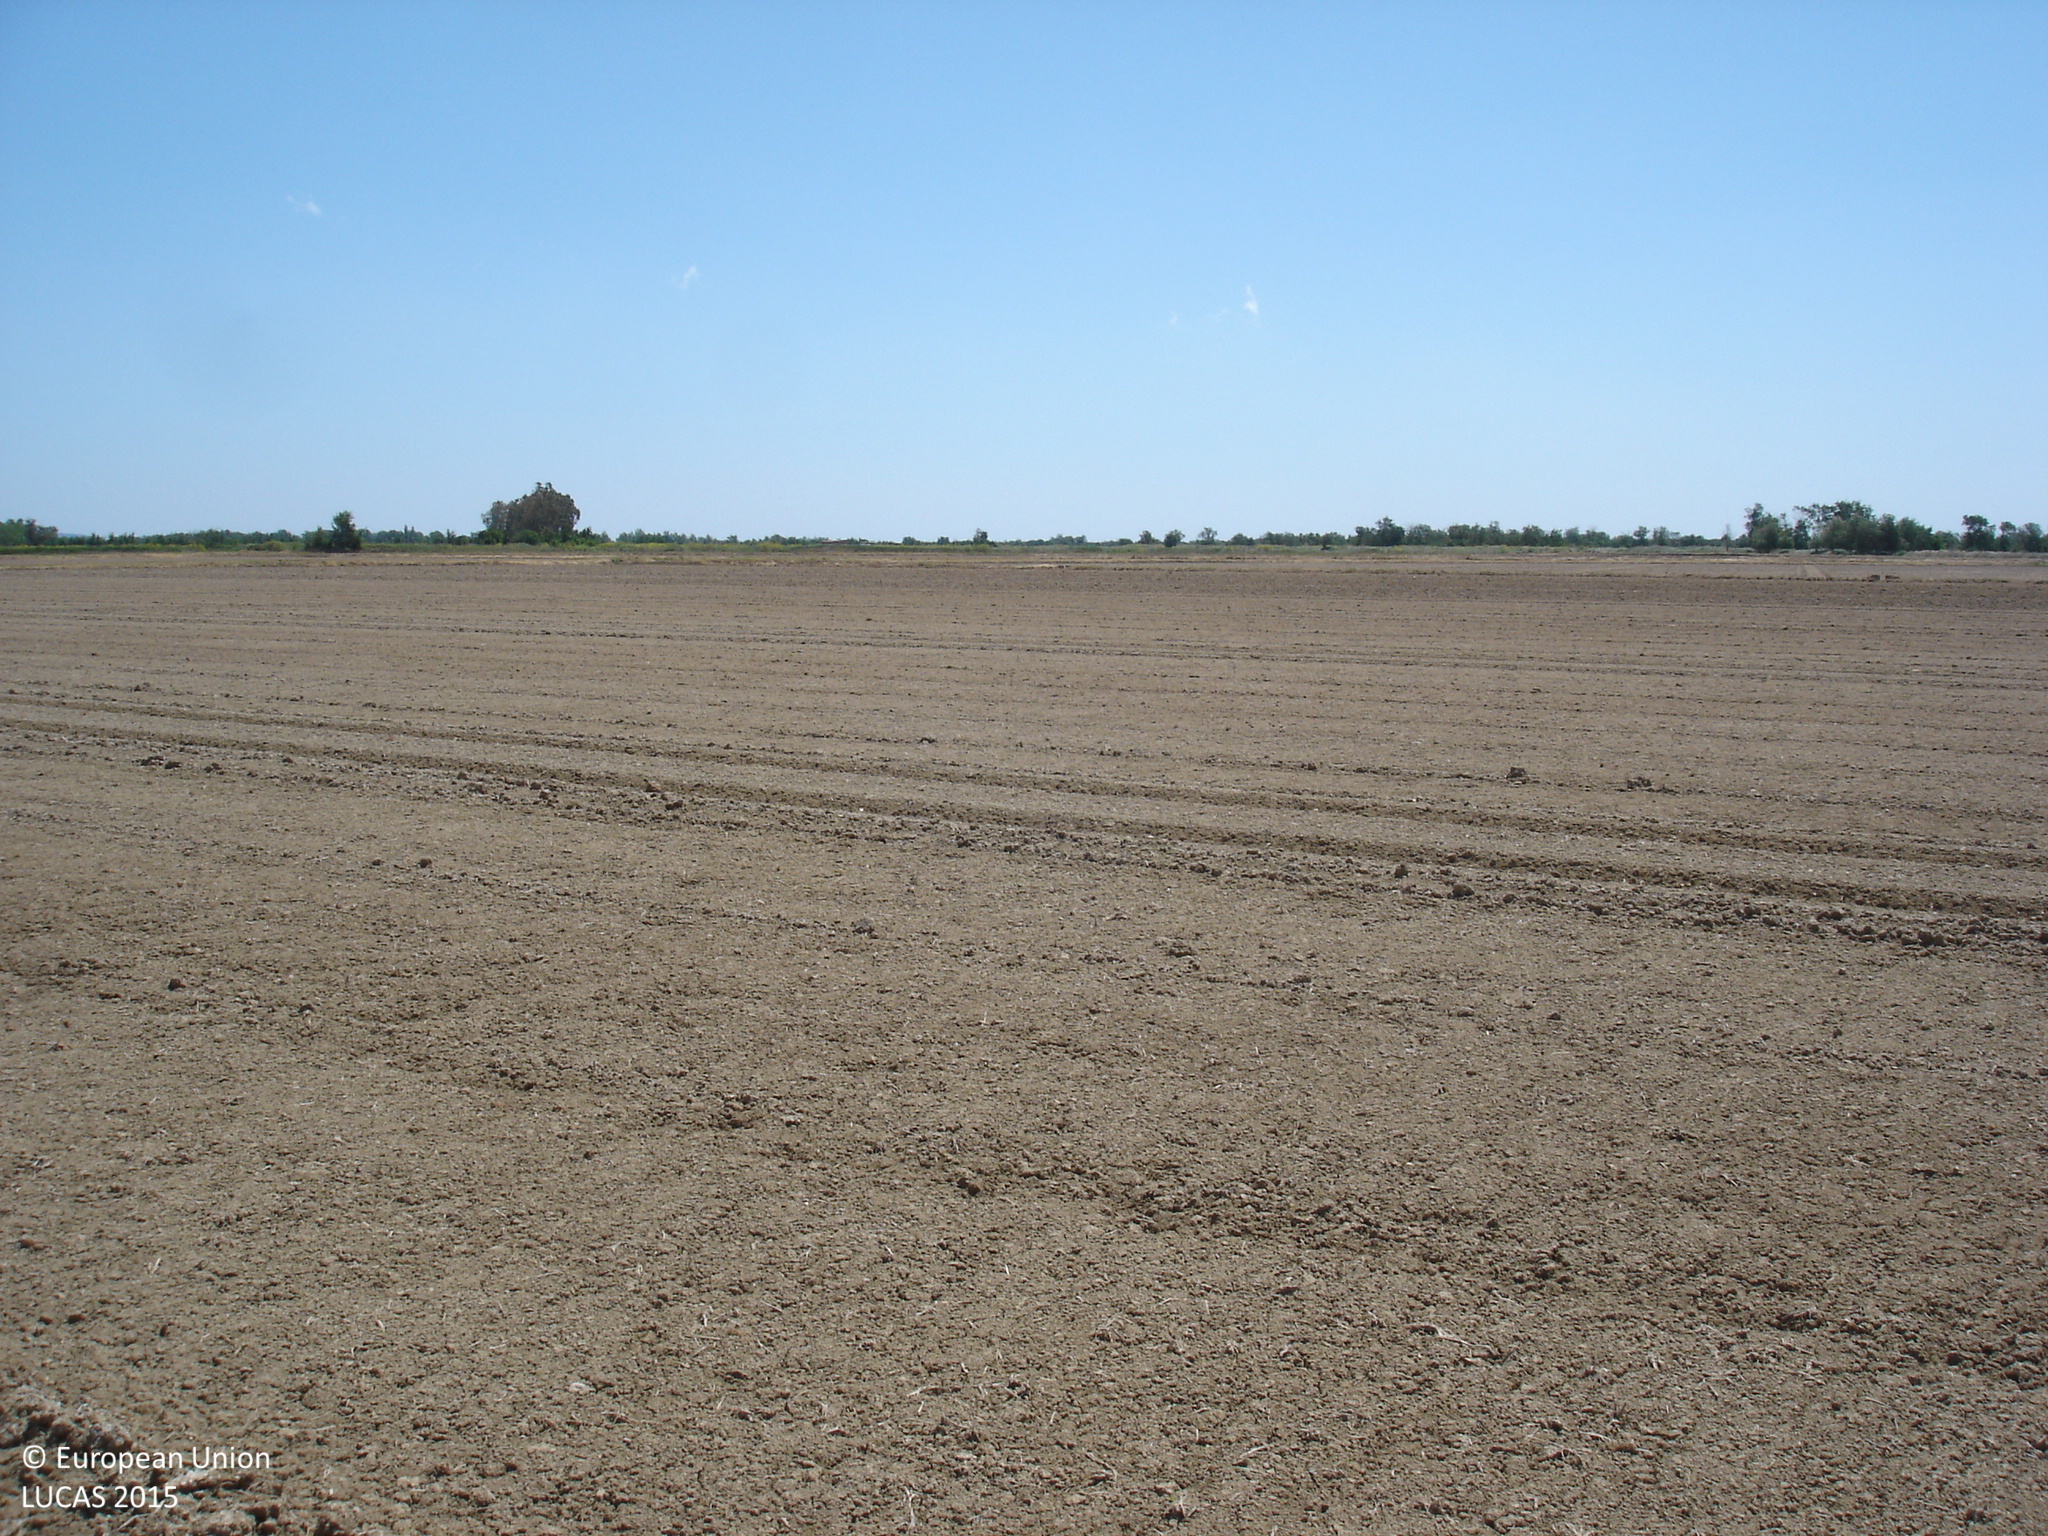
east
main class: Cropland
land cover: Rice
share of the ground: < 10 %
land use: Agriculture (excluding fallow land and kitchen gardens)
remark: Tilled/Sowed
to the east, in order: Rice; Grass margins; Tracks; Grass margins; Ditches and canals; Grass margins; Rice
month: May
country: ES
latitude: 42.2157
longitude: 3.0492
